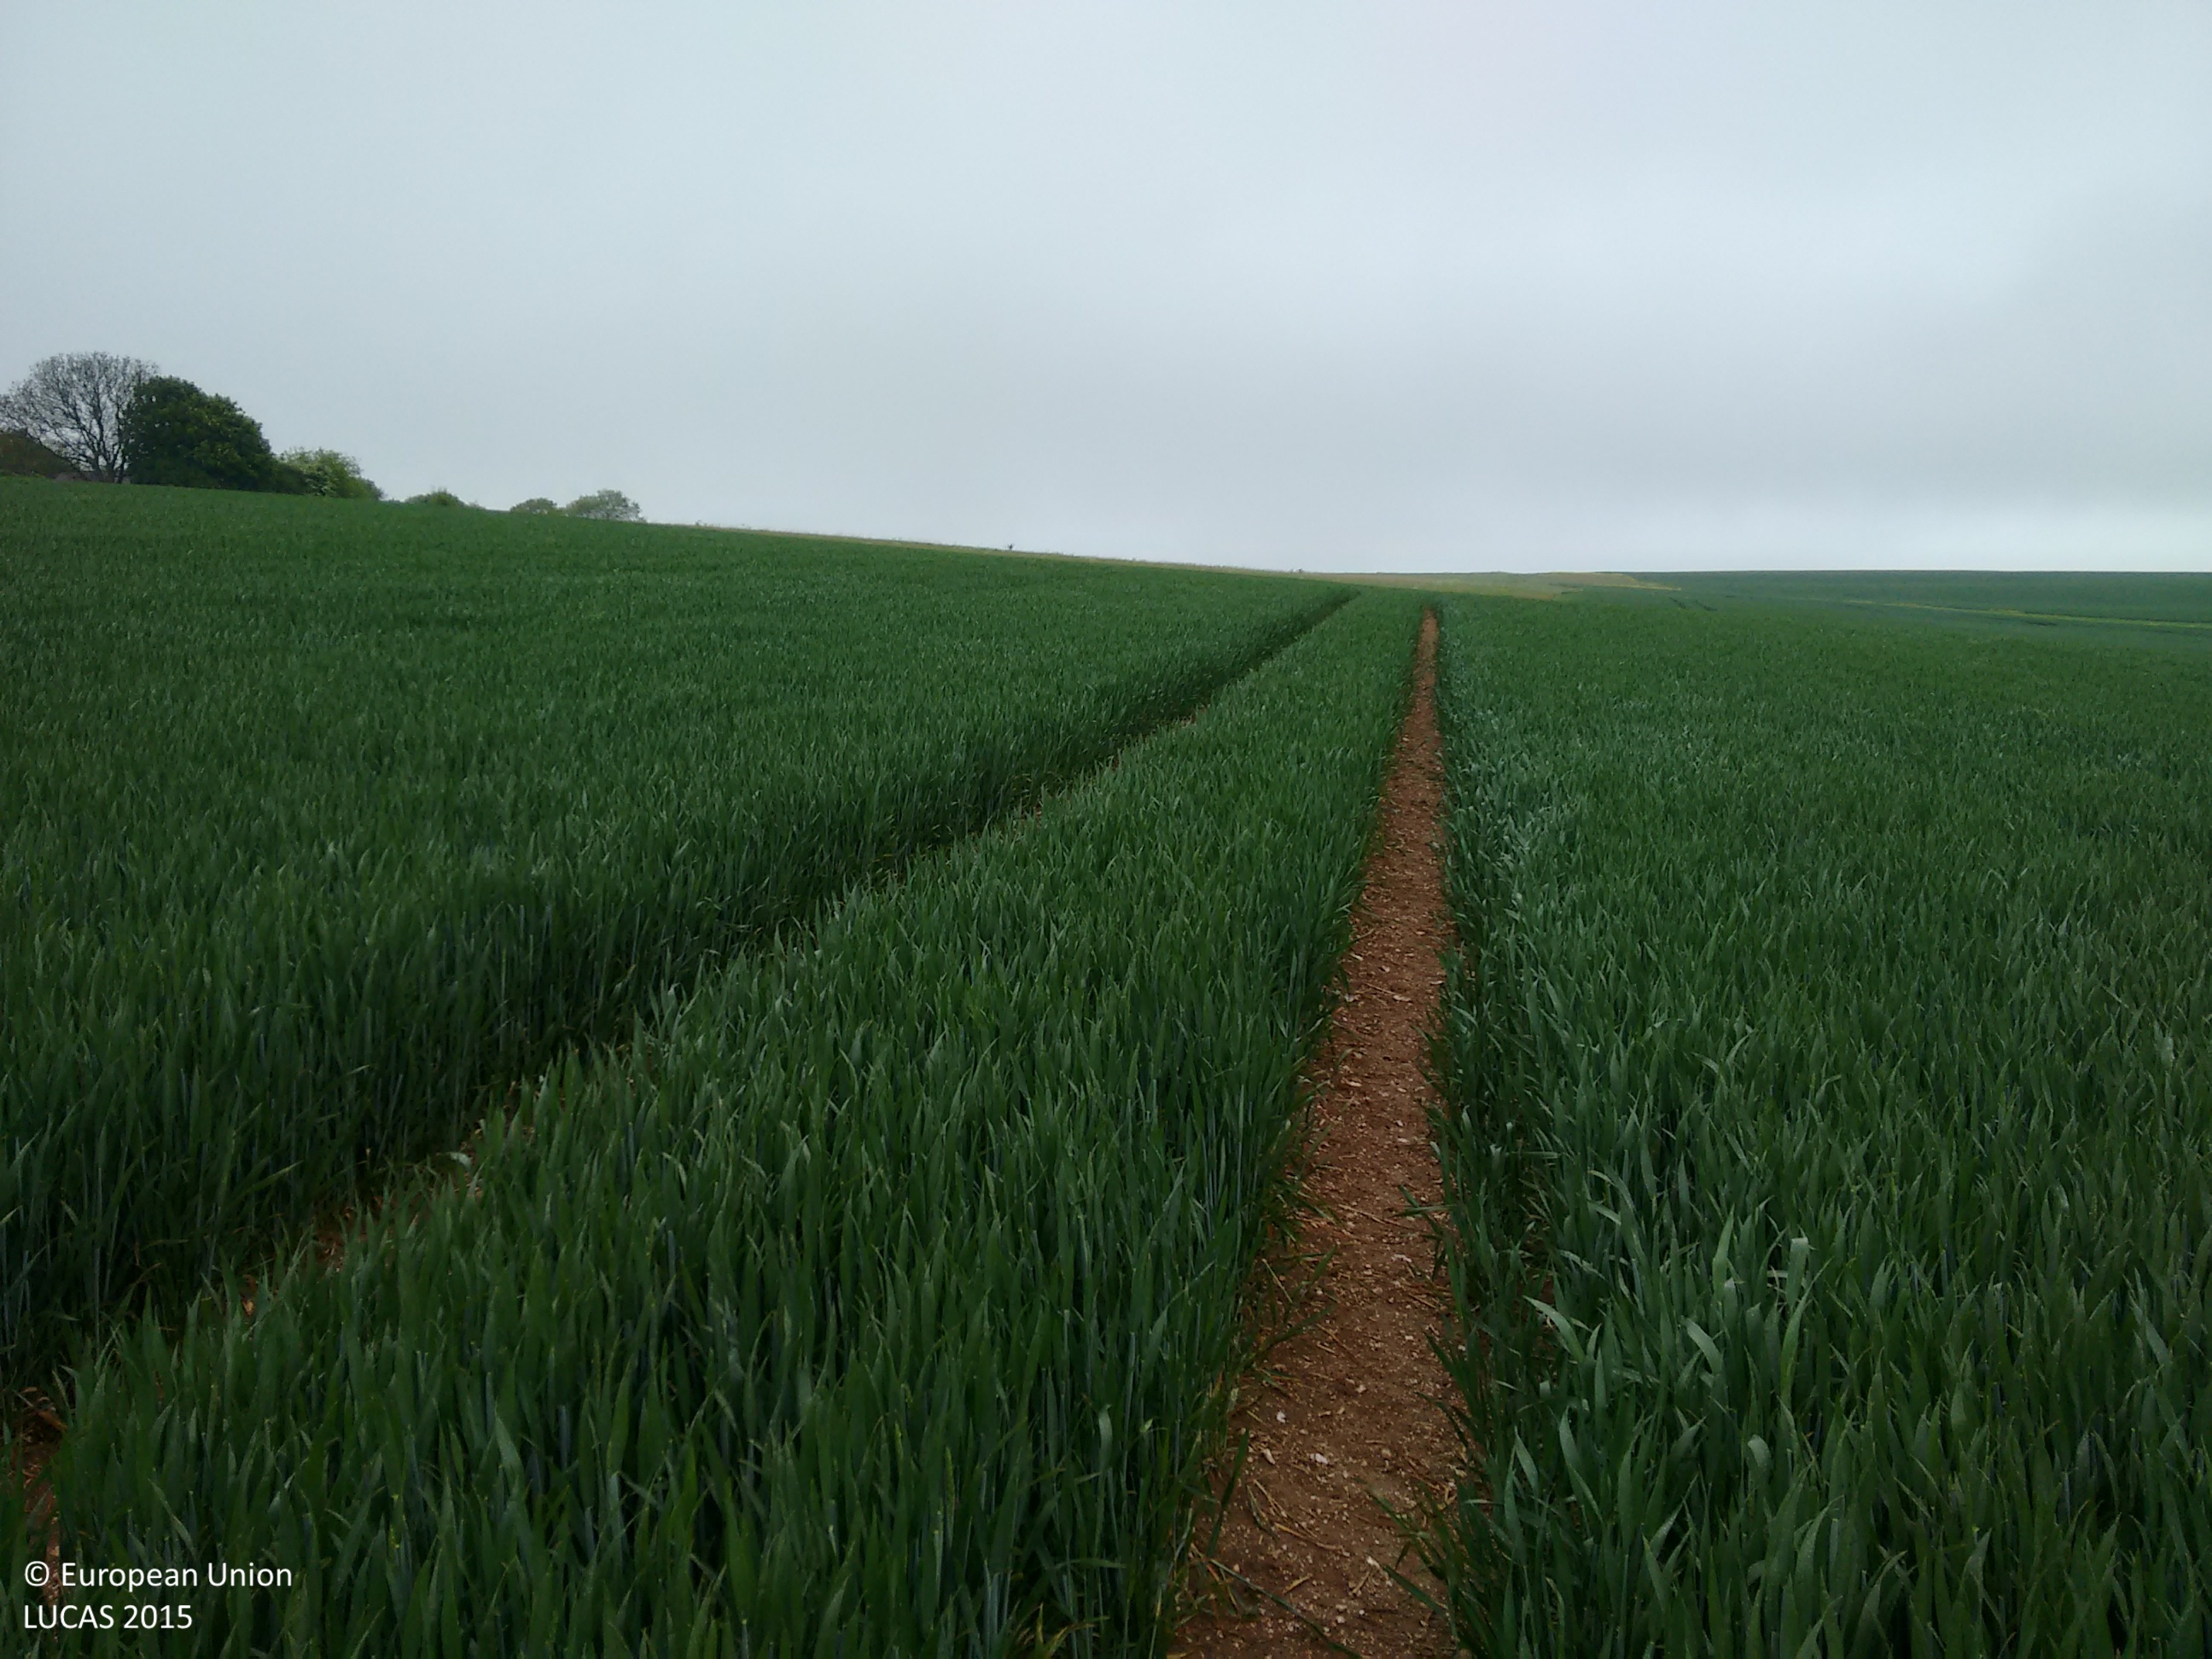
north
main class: Cropland
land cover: Common wheat
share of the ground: > 75 %
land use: Agriculture (excluding fallow land and kitchen gardens)
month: May
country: GB
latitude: 50.9347
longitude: -1.0445
